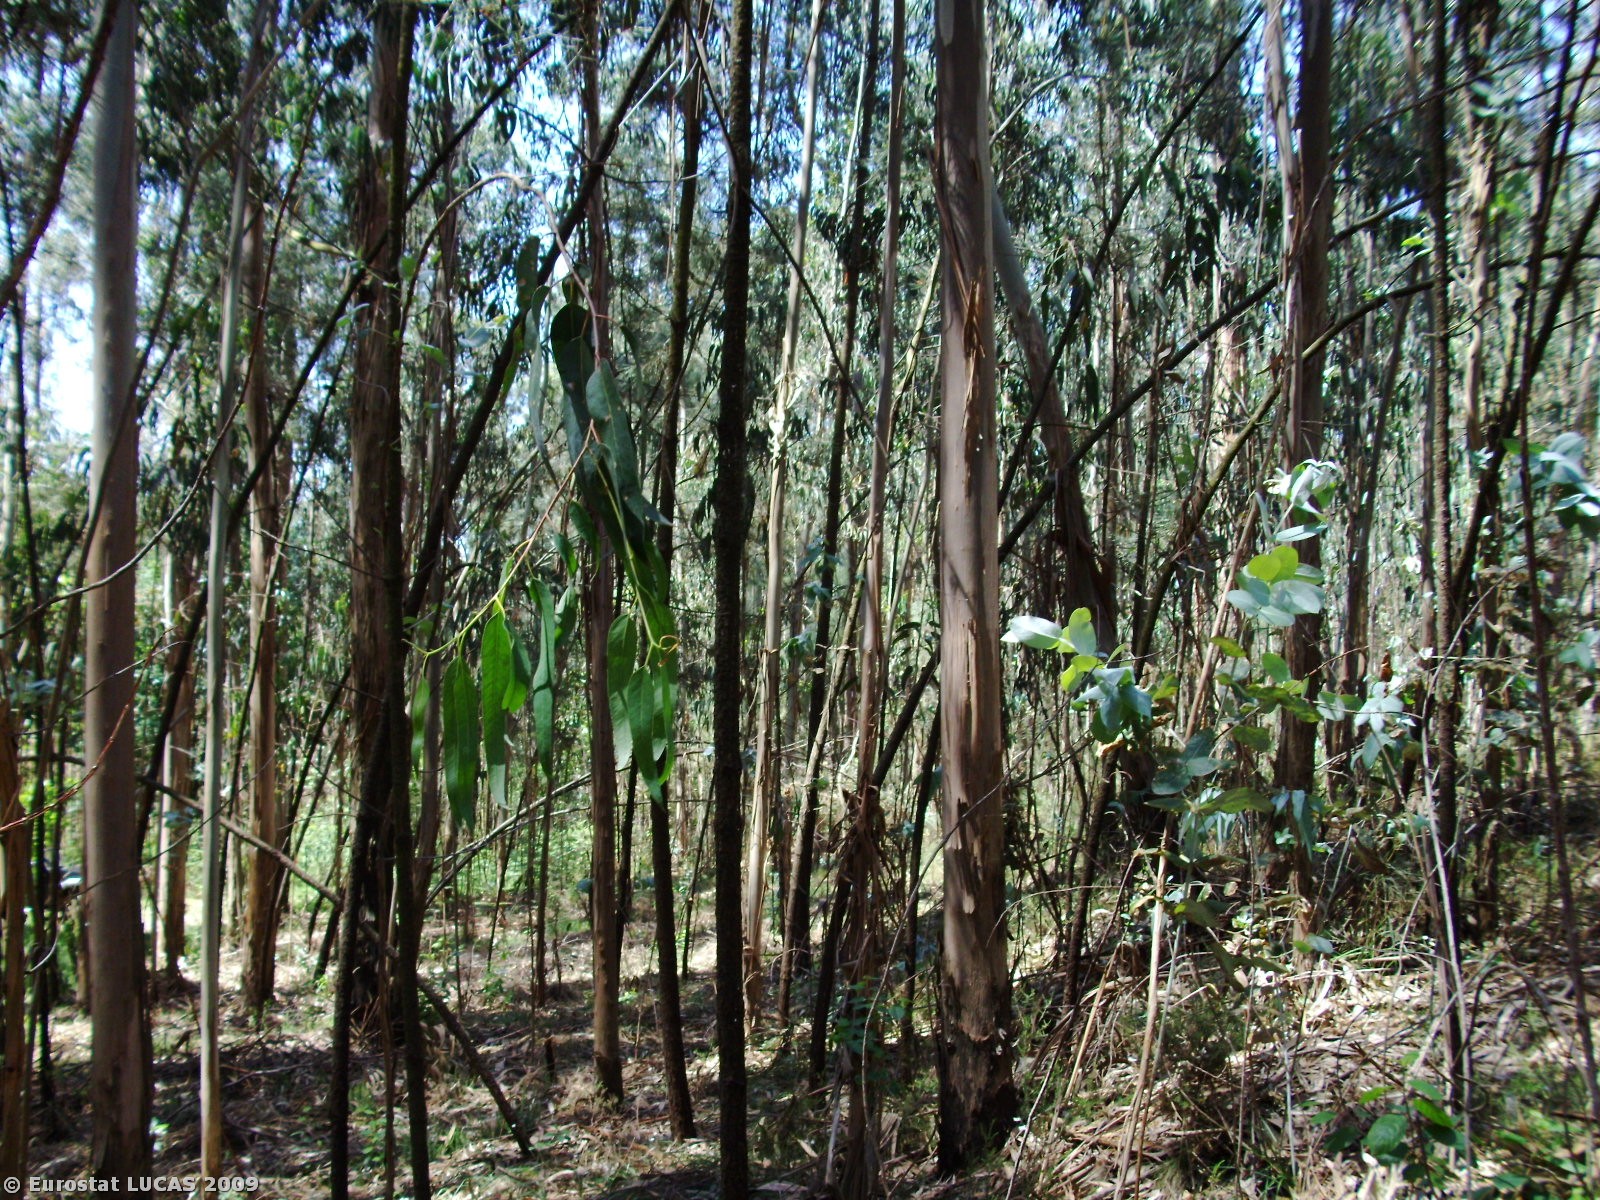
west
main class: Woodland
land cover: Mixed woodland
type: coniferous forest of the mediterranean region
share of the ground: > 75 %
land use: Forestry
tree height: > 5 m
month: May
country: PT
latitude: 40.7670
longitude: -8.4933
